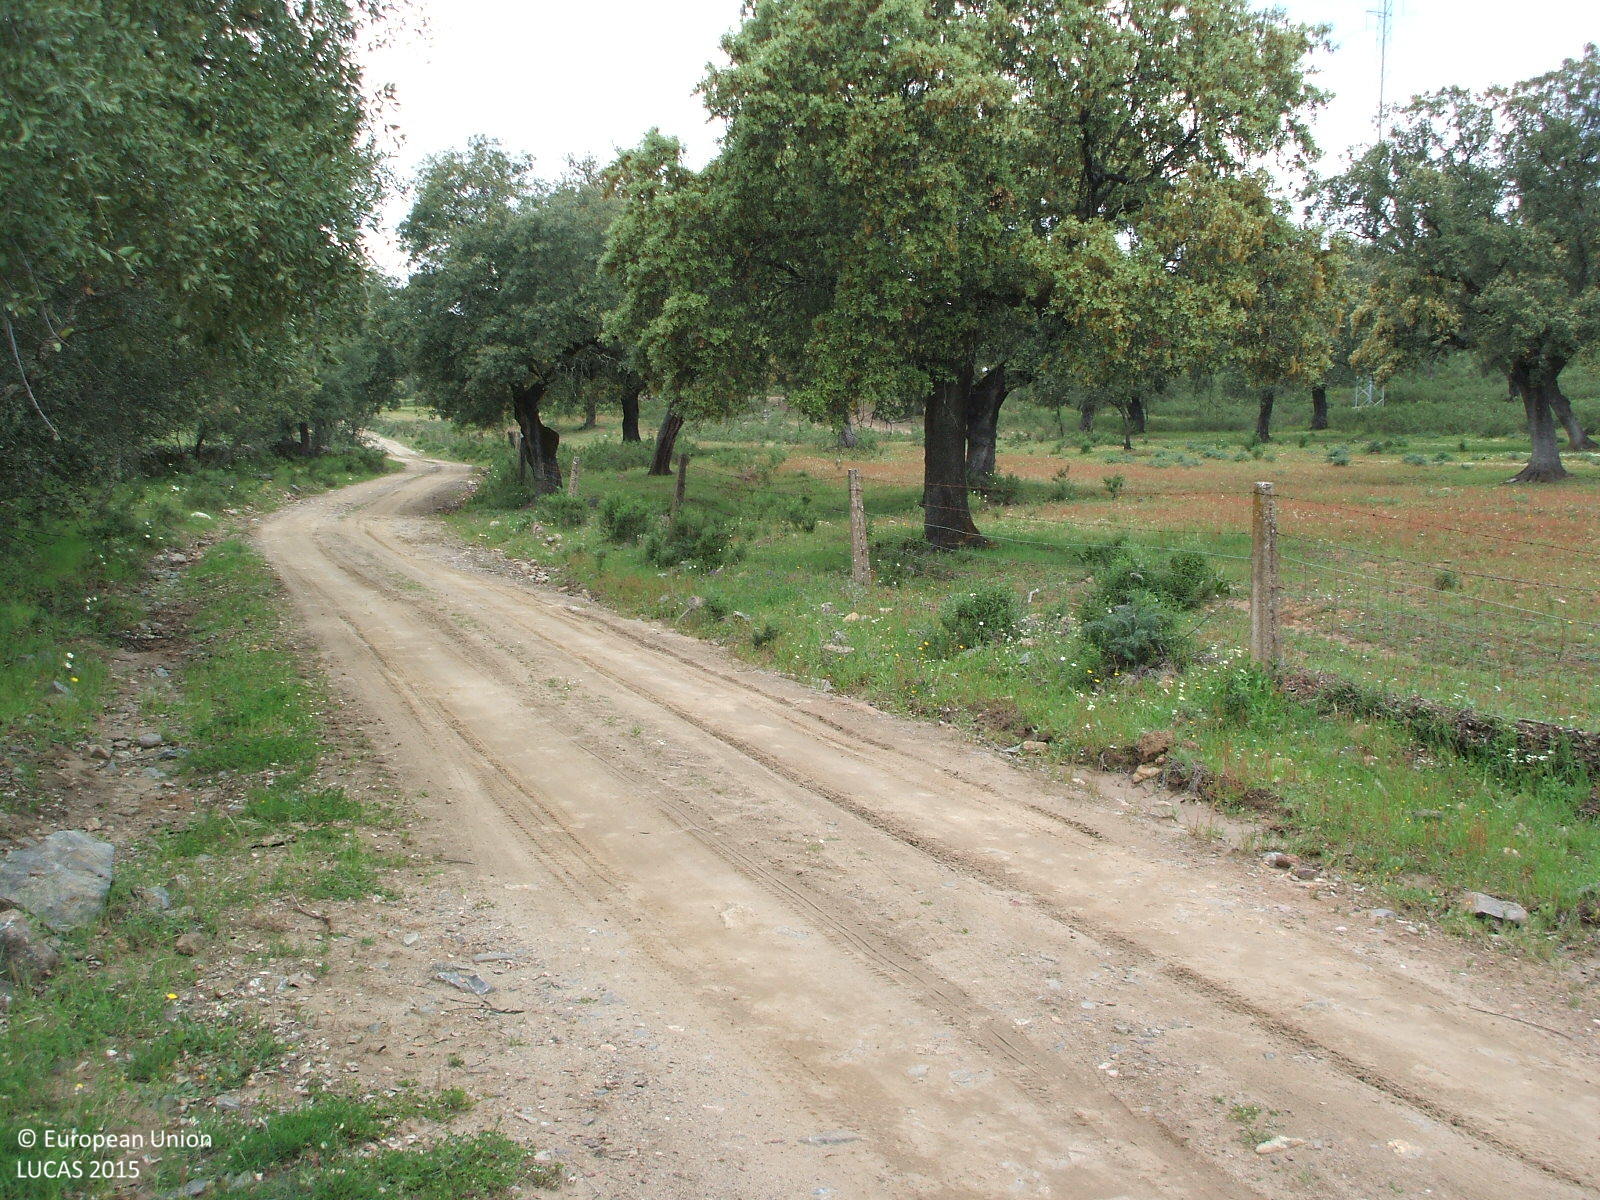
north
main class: Woodland
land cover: Broadleaved woodland
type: broadleaved evergreen forest
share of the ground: 25 - 50 %
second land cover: Grassland without tree/shrub cover
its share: > 75 %
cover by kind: herbaceous plants 70 %, broadleaved forest trees 30 %
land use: Forestry
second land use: Agriculture (excluding fallow land and kitchen gardens)
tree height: > 5 m
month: April
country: ES
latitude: 37.9513
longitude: -6.2095
